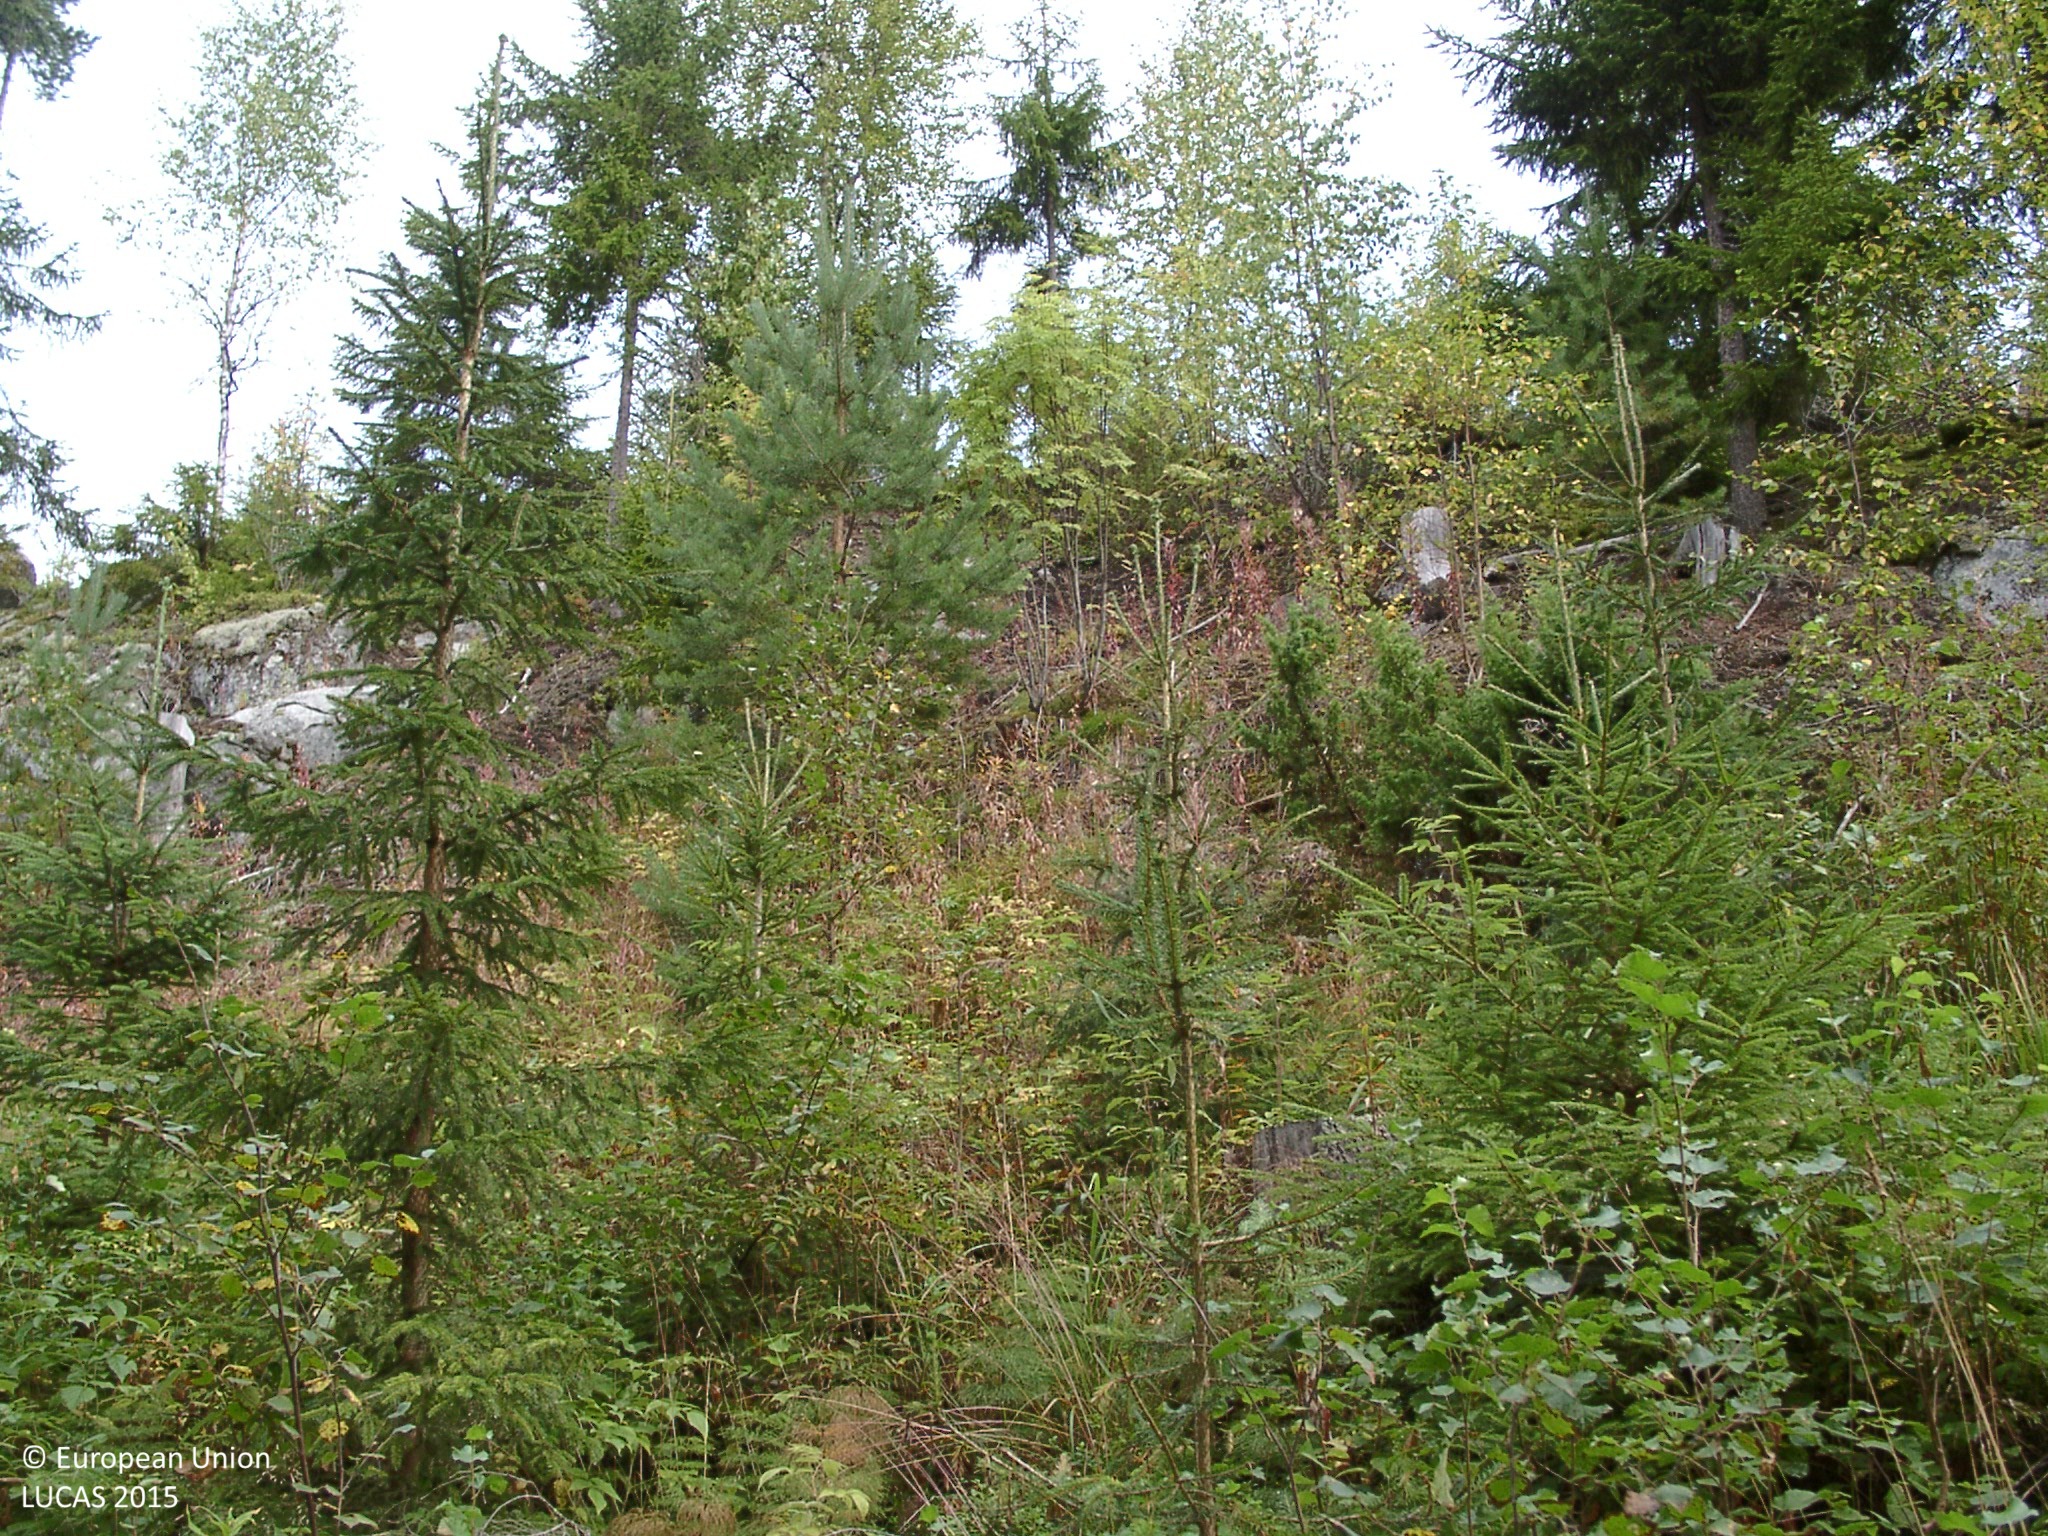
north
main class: Woodland
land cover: Spruce dominated mixed woodland
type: boreal forest
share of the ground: 25 - 50 %
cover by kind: herbaceous plants 50 %, broadleaved forest trees 15 %, shrubs 15 %, coniferous forest trees 10 %, consolidated bare surface 5 %, unconsolidated bare surface 5 %
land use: Forestry
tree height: < 5 m
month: August
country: FI
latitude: 62.3974
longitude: 25.0967
